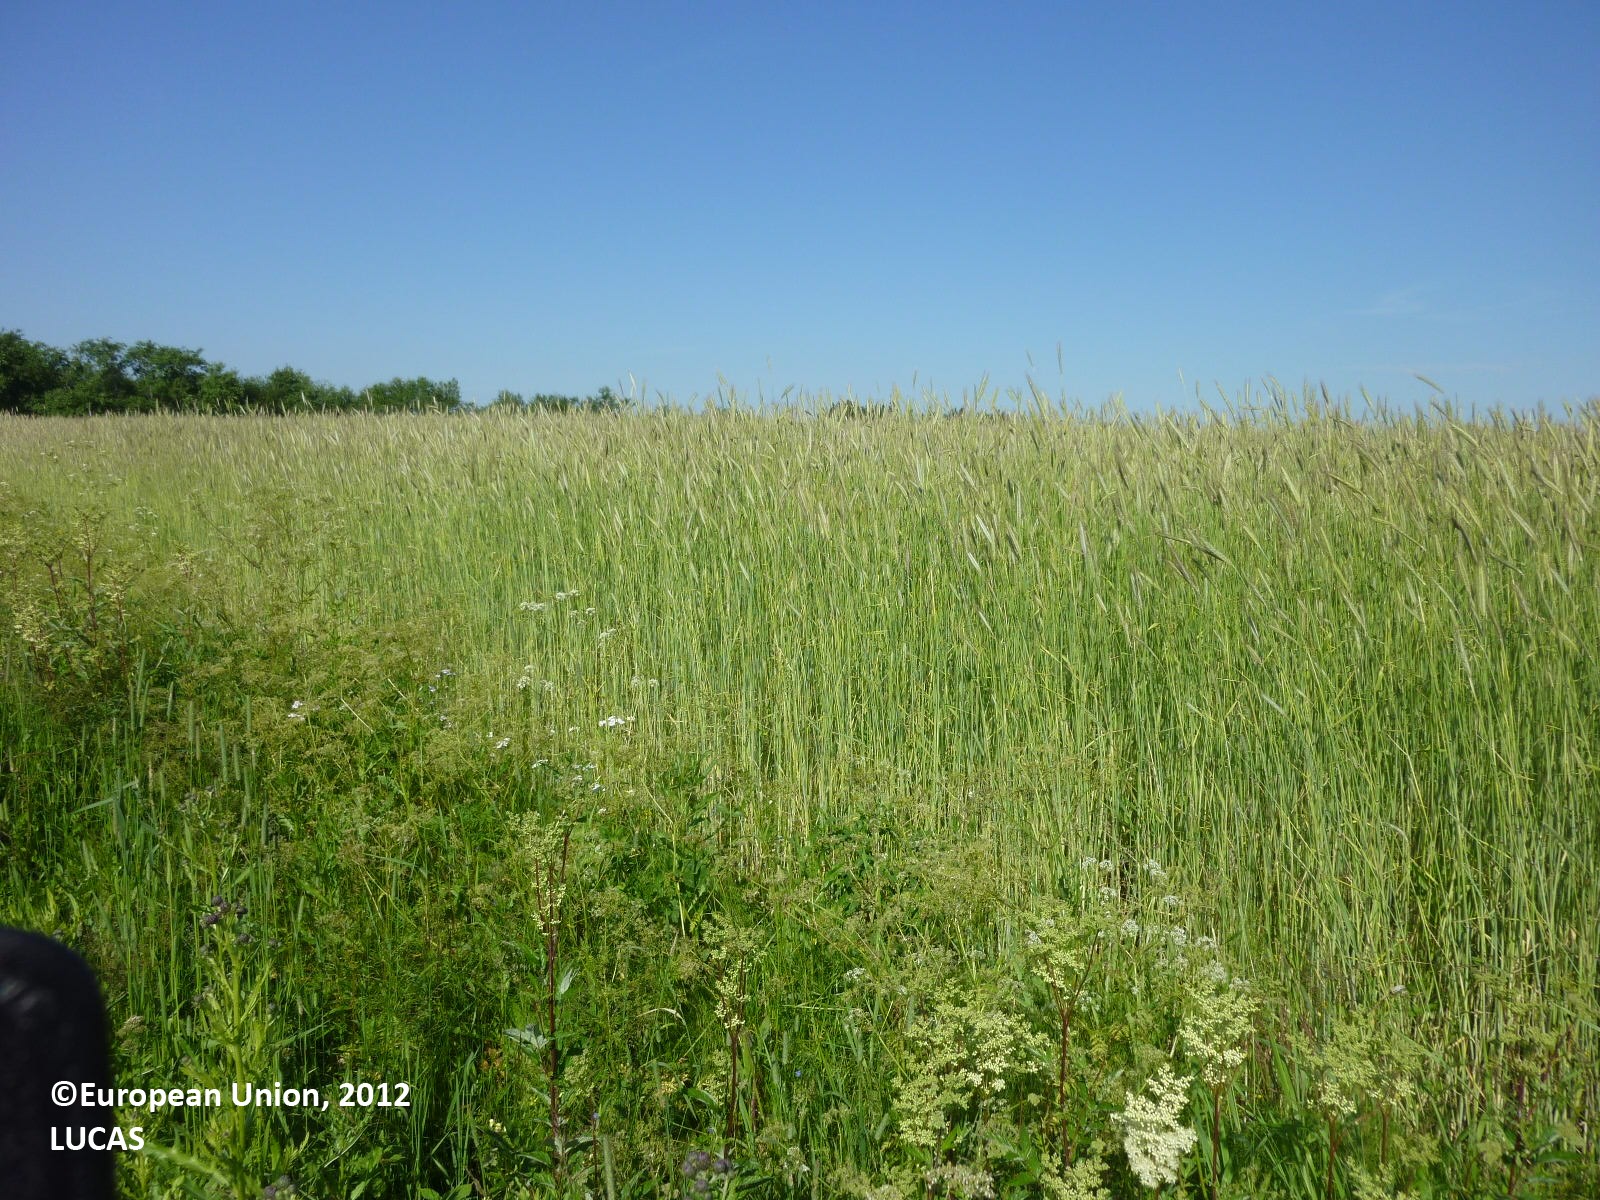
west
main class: Cropland
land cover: Rye
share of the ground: > 75 %
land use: Agriculture (excluding fallow land and kitchen gardens)
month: July
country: FI
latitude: 61.2400
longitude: 22.3790
